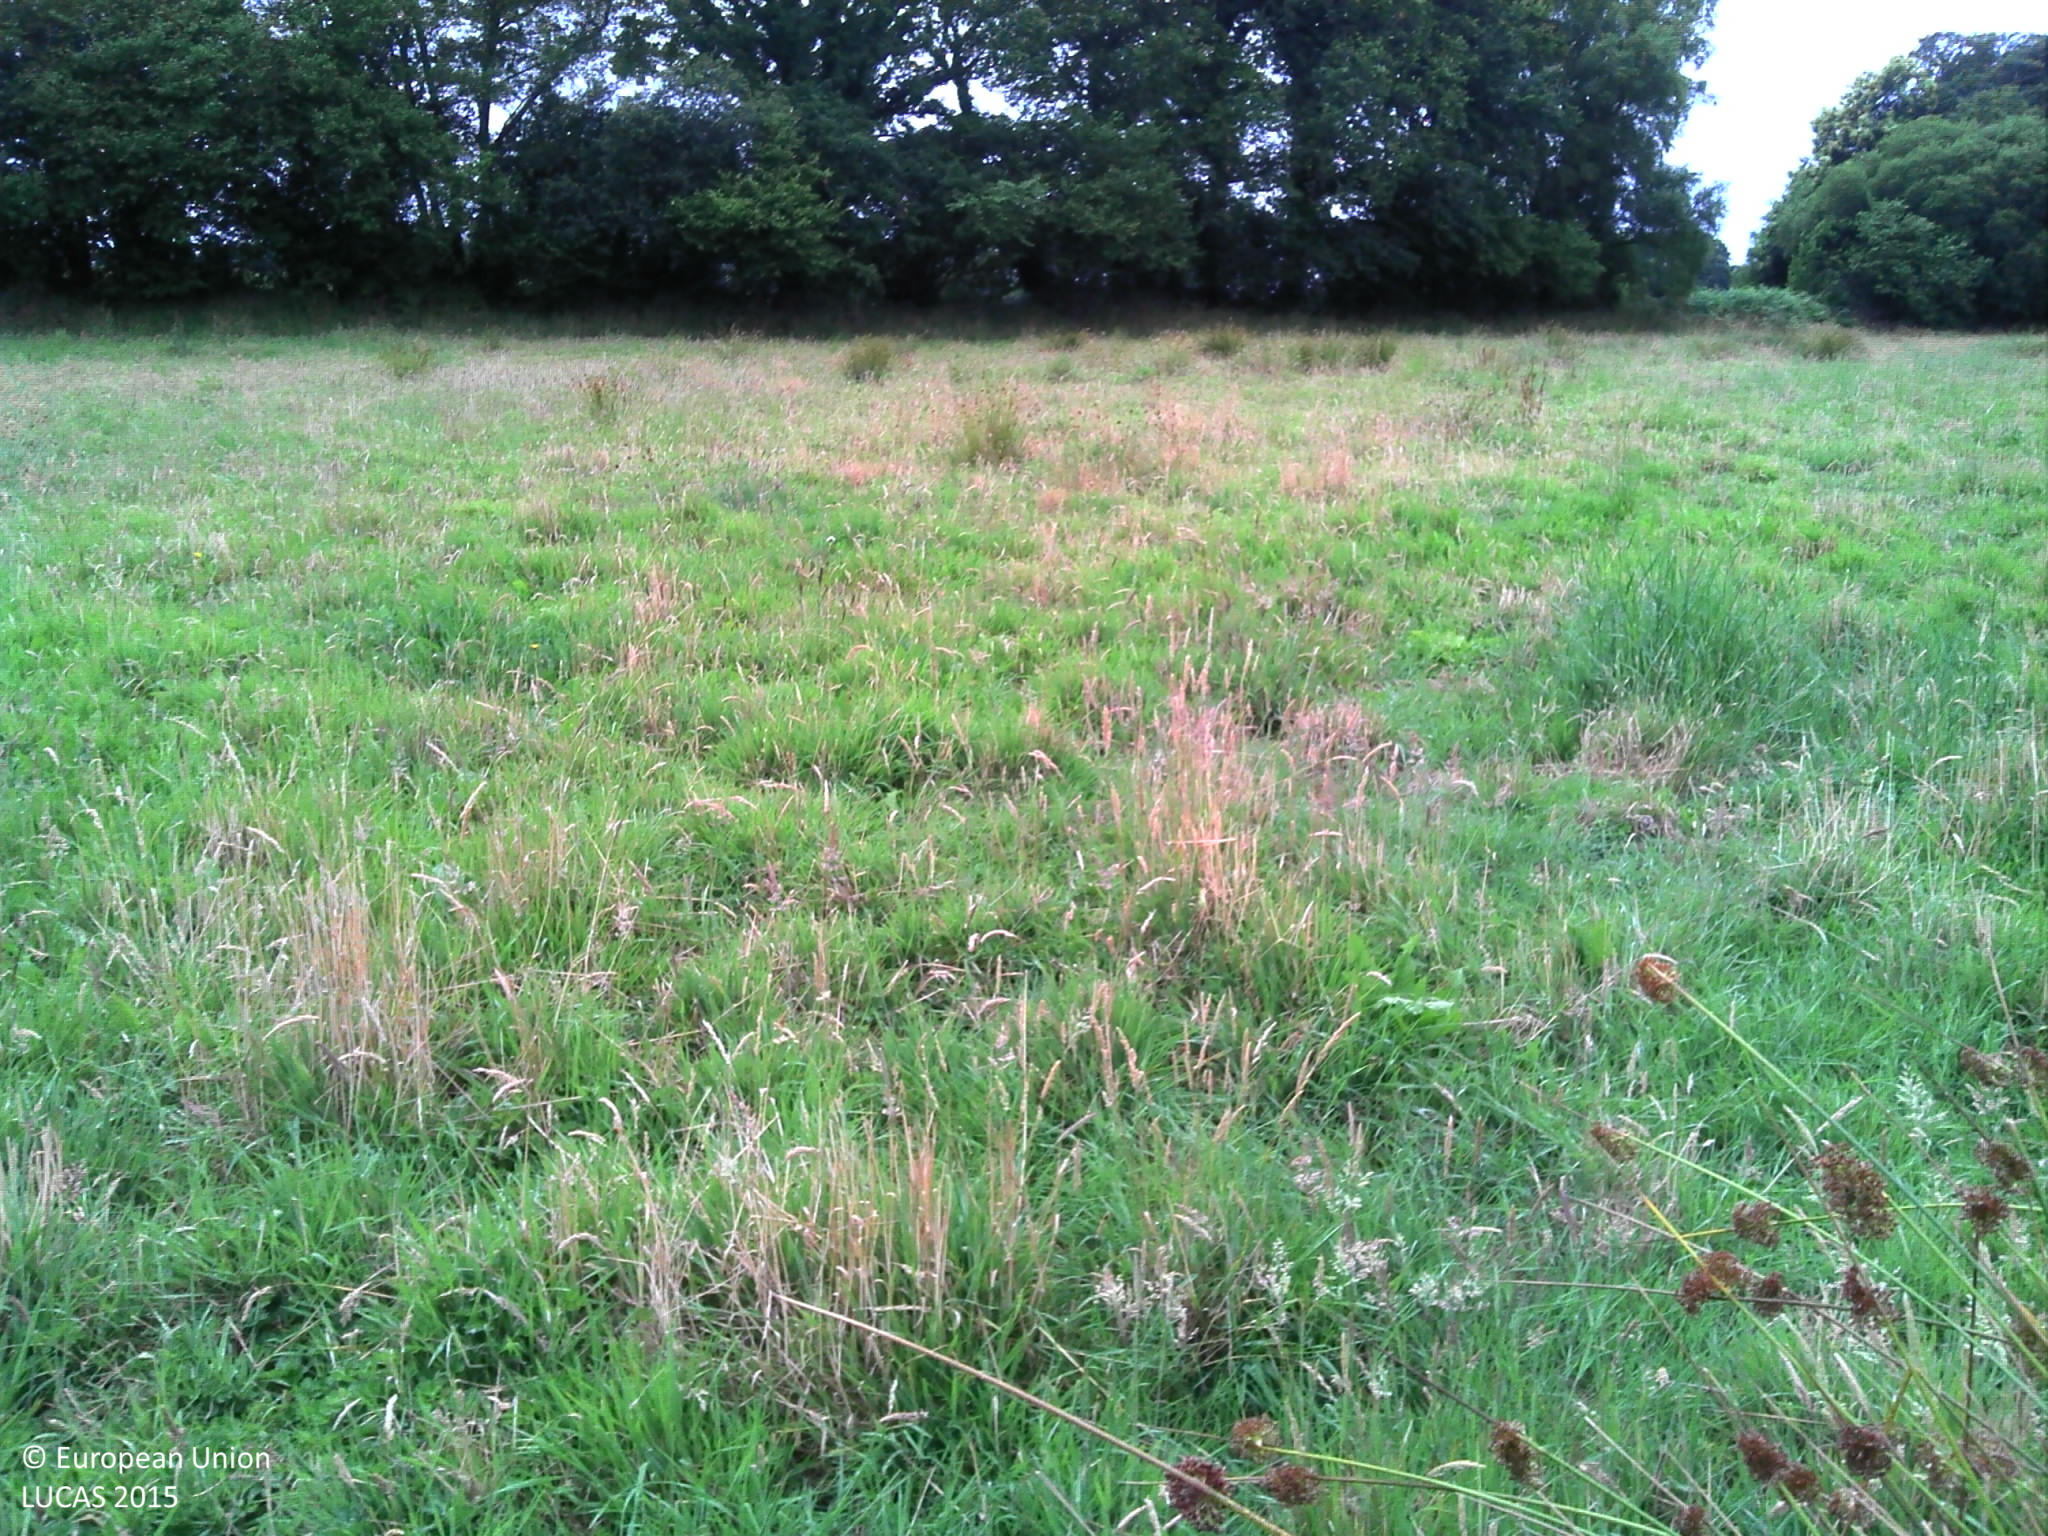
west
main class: Grassland
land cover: Grassland without tree/shrub cover
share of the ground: > 75 %
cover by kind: herbaceous plants 100 %
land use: Agriculture (excluding fallow land and kitchen gardens)
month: July
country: FR
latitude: 48.1340
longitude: -3.6656
